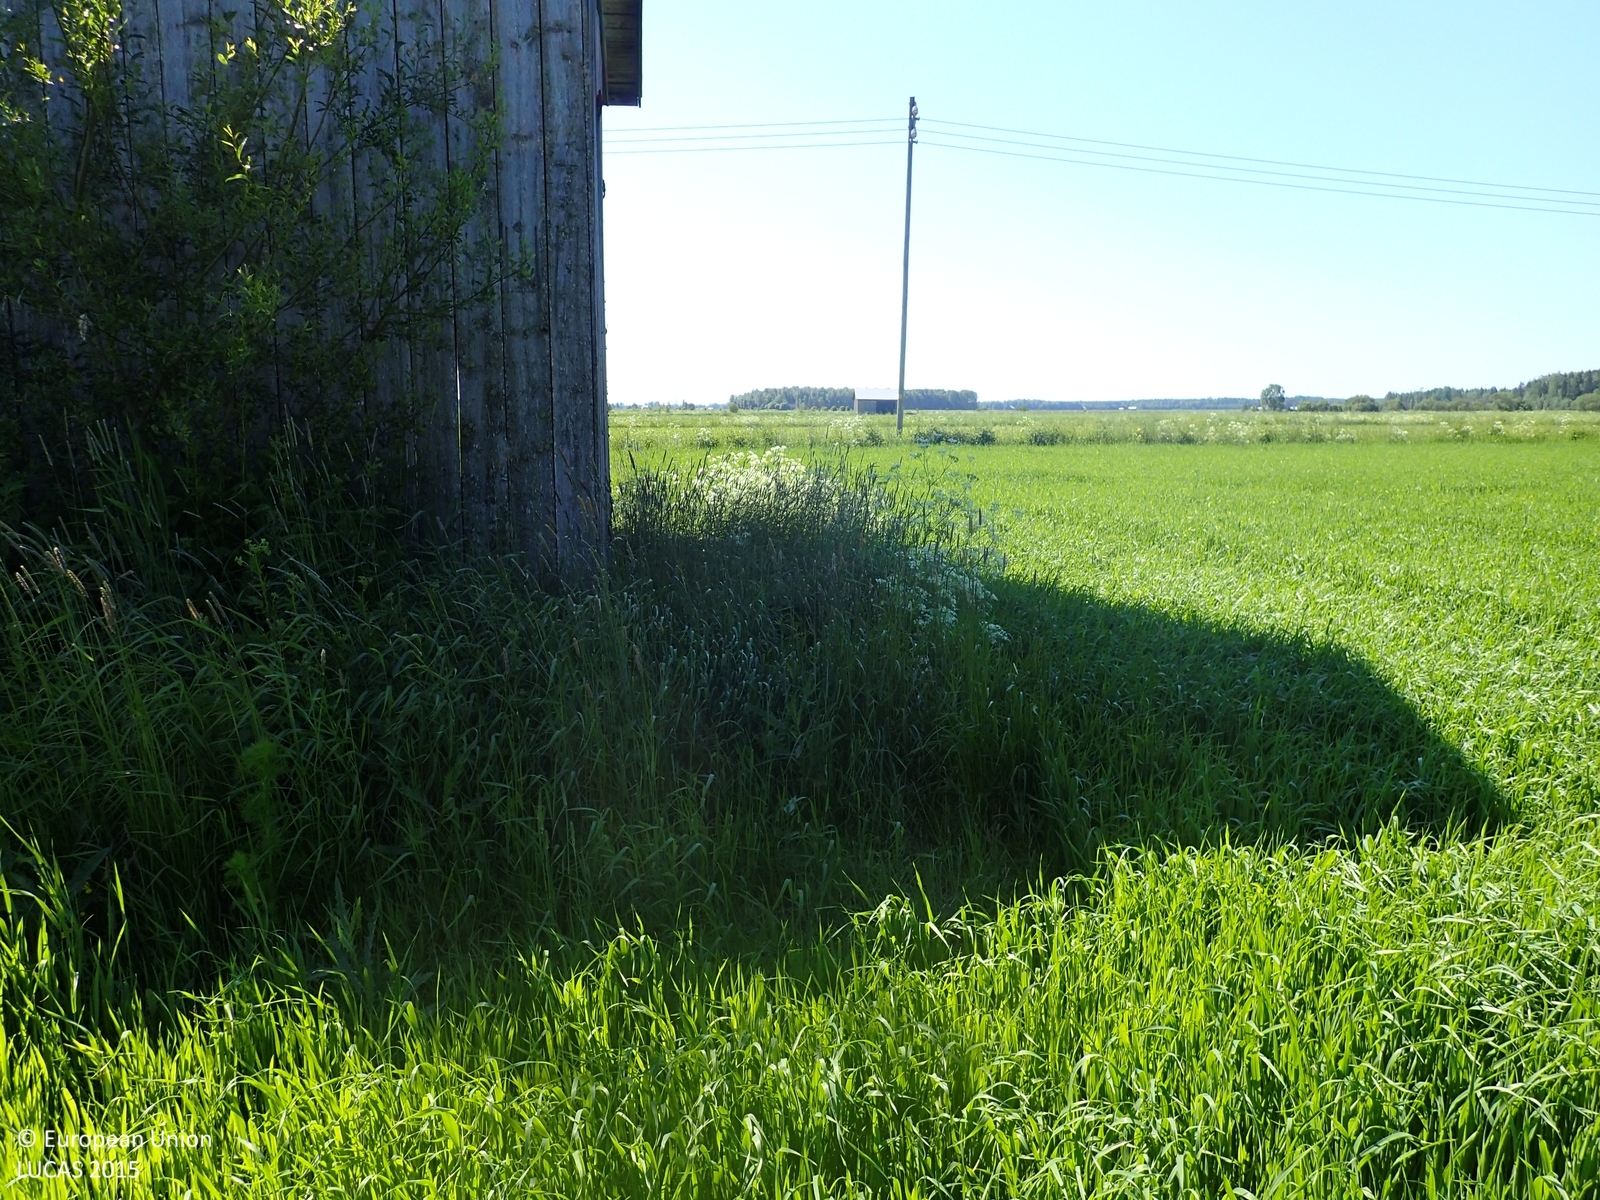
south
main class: Cropland
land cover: Oats
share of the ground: > 75 %
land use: Agriculture (excluding fallow land and kitchen gardens)
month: July
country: FI
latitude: 62.6129
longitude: 21.4413
